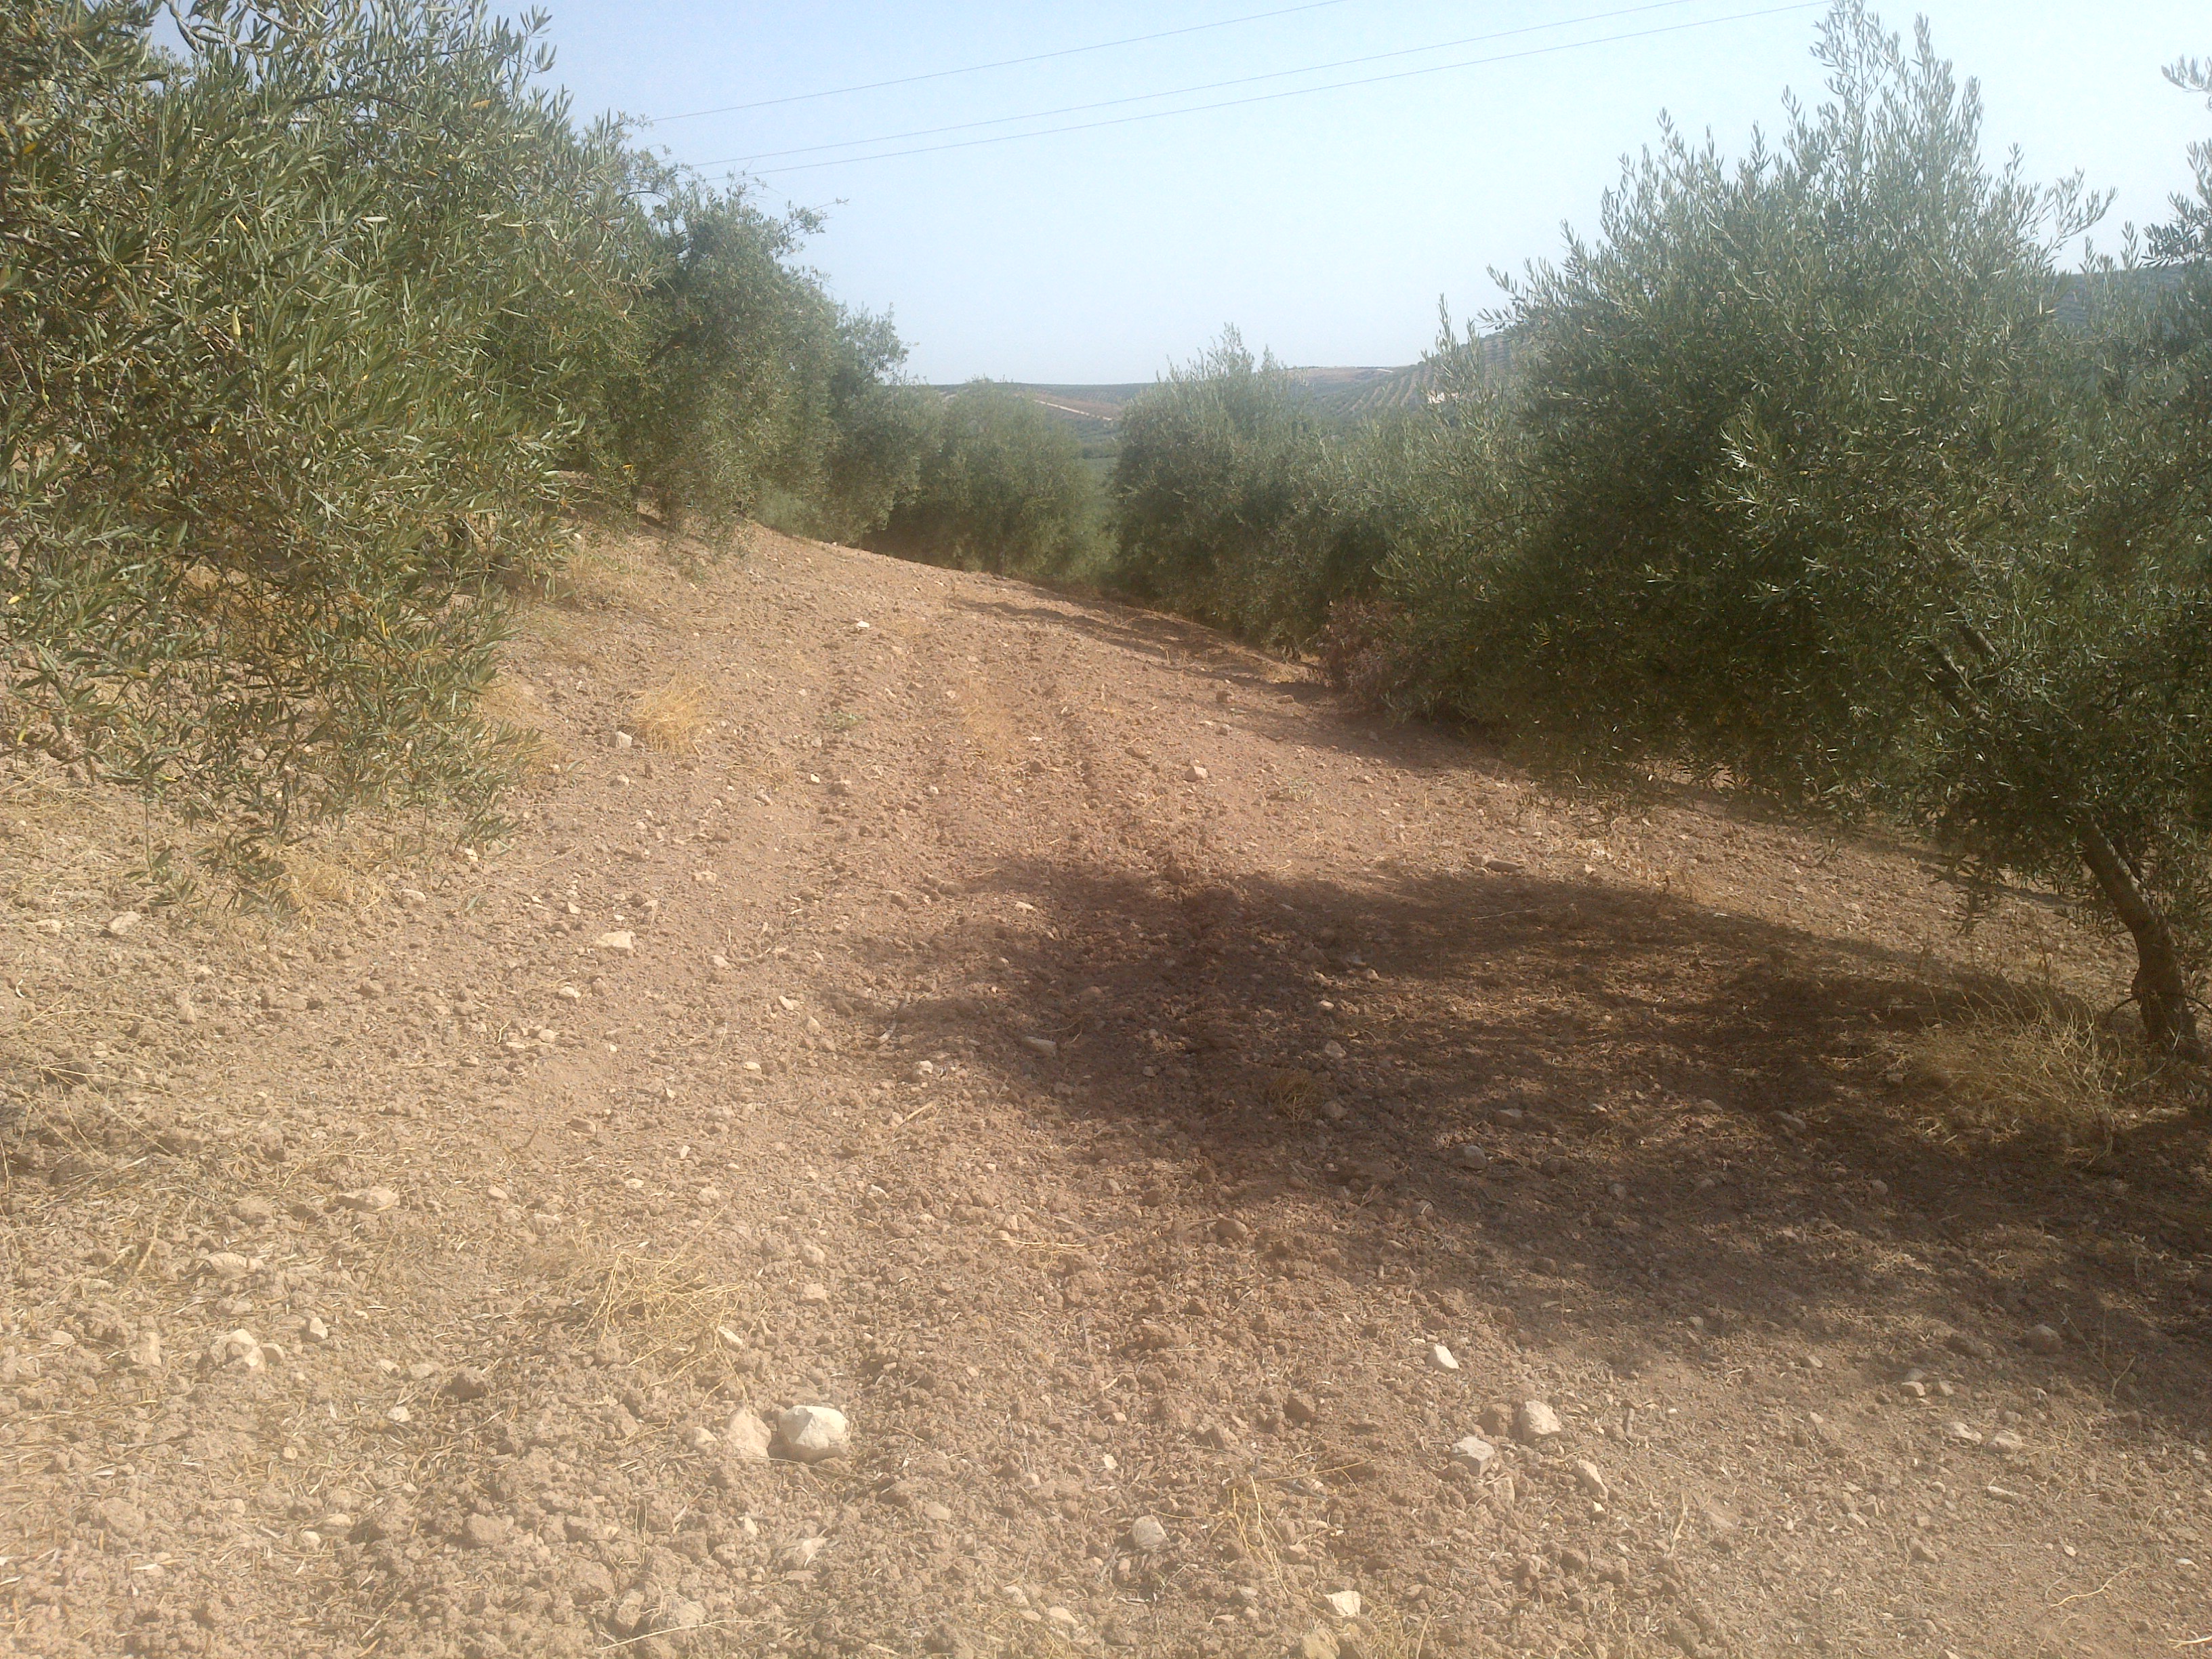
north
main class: Cropland
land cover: Olive groves
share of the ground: 50 - 75 %
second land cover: Other bare soil
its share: > 75 %
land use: Agriculture (excluding fallow land and kitchen gardens)
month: June
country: ES
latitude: 37.6782
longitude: -4.2569
